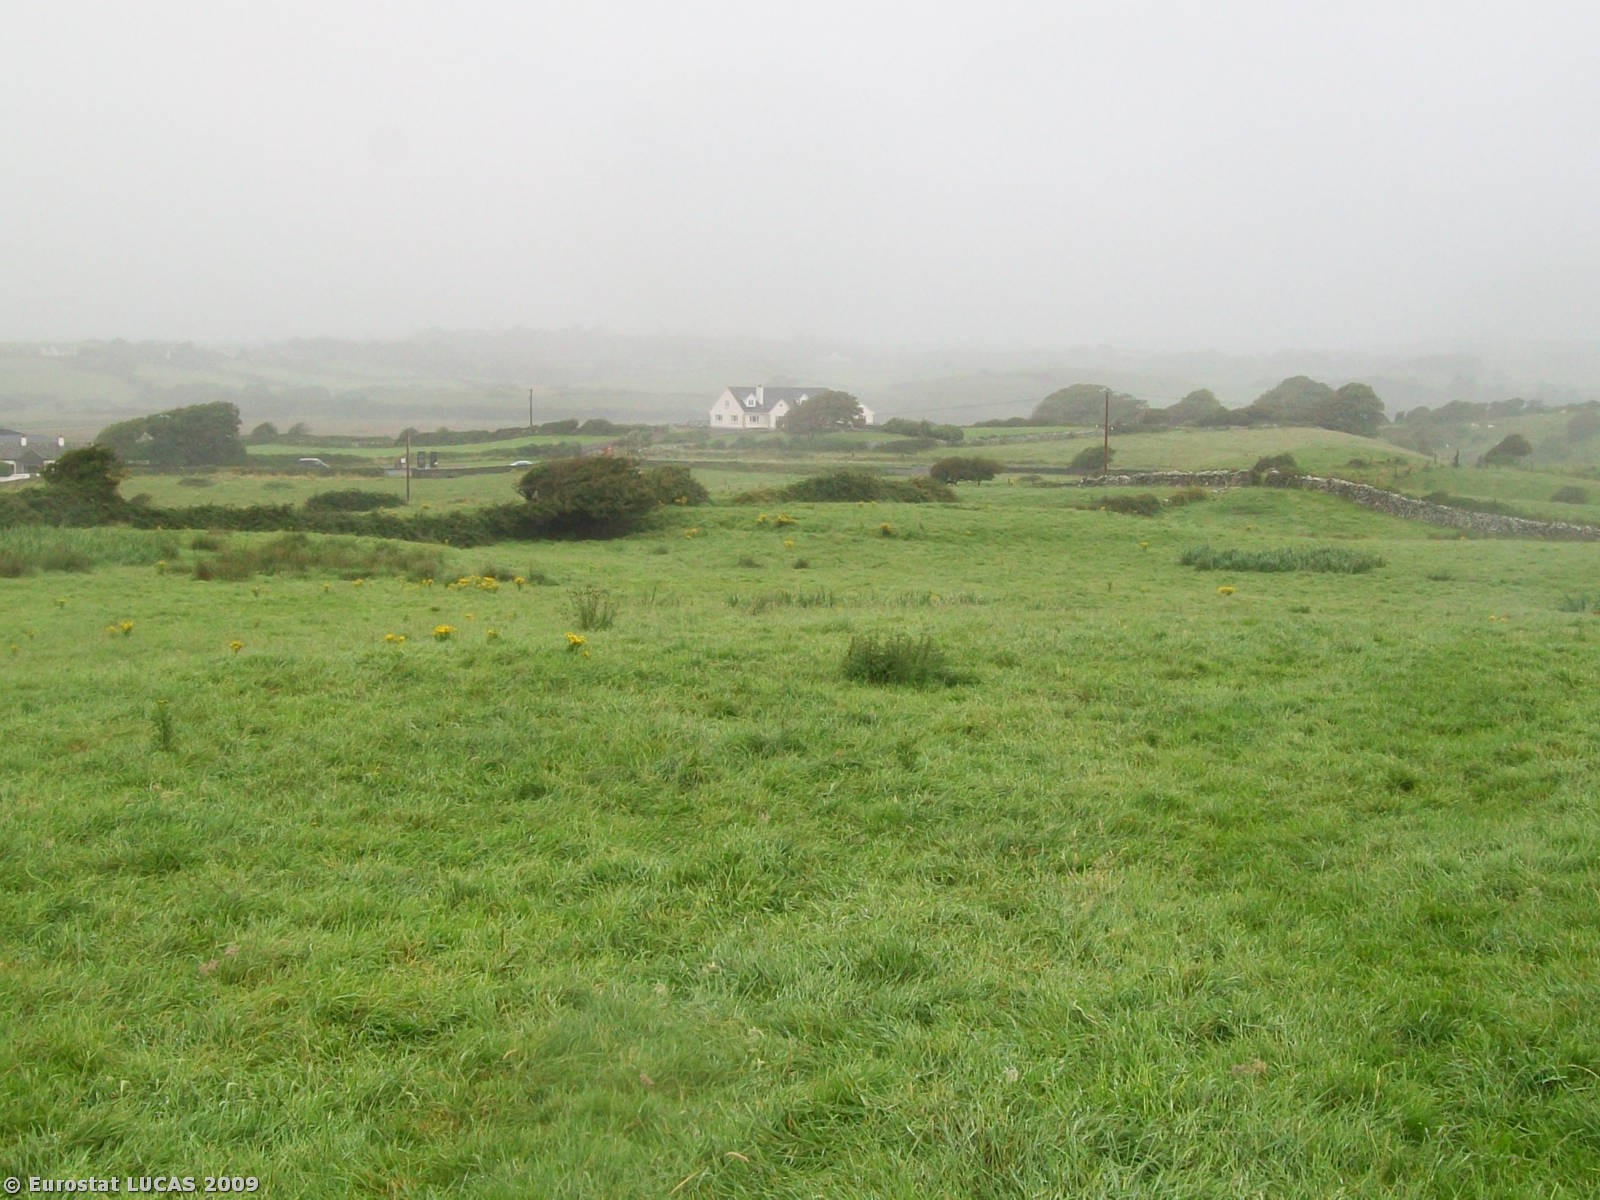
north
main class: Grassland
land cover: Grassland without tree/shrub cover
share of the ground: > 75 %
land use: Agriculture (excluding fallow land and kitchen gardens)
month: August
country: IE
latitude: 52.9357
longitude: -9.3145
